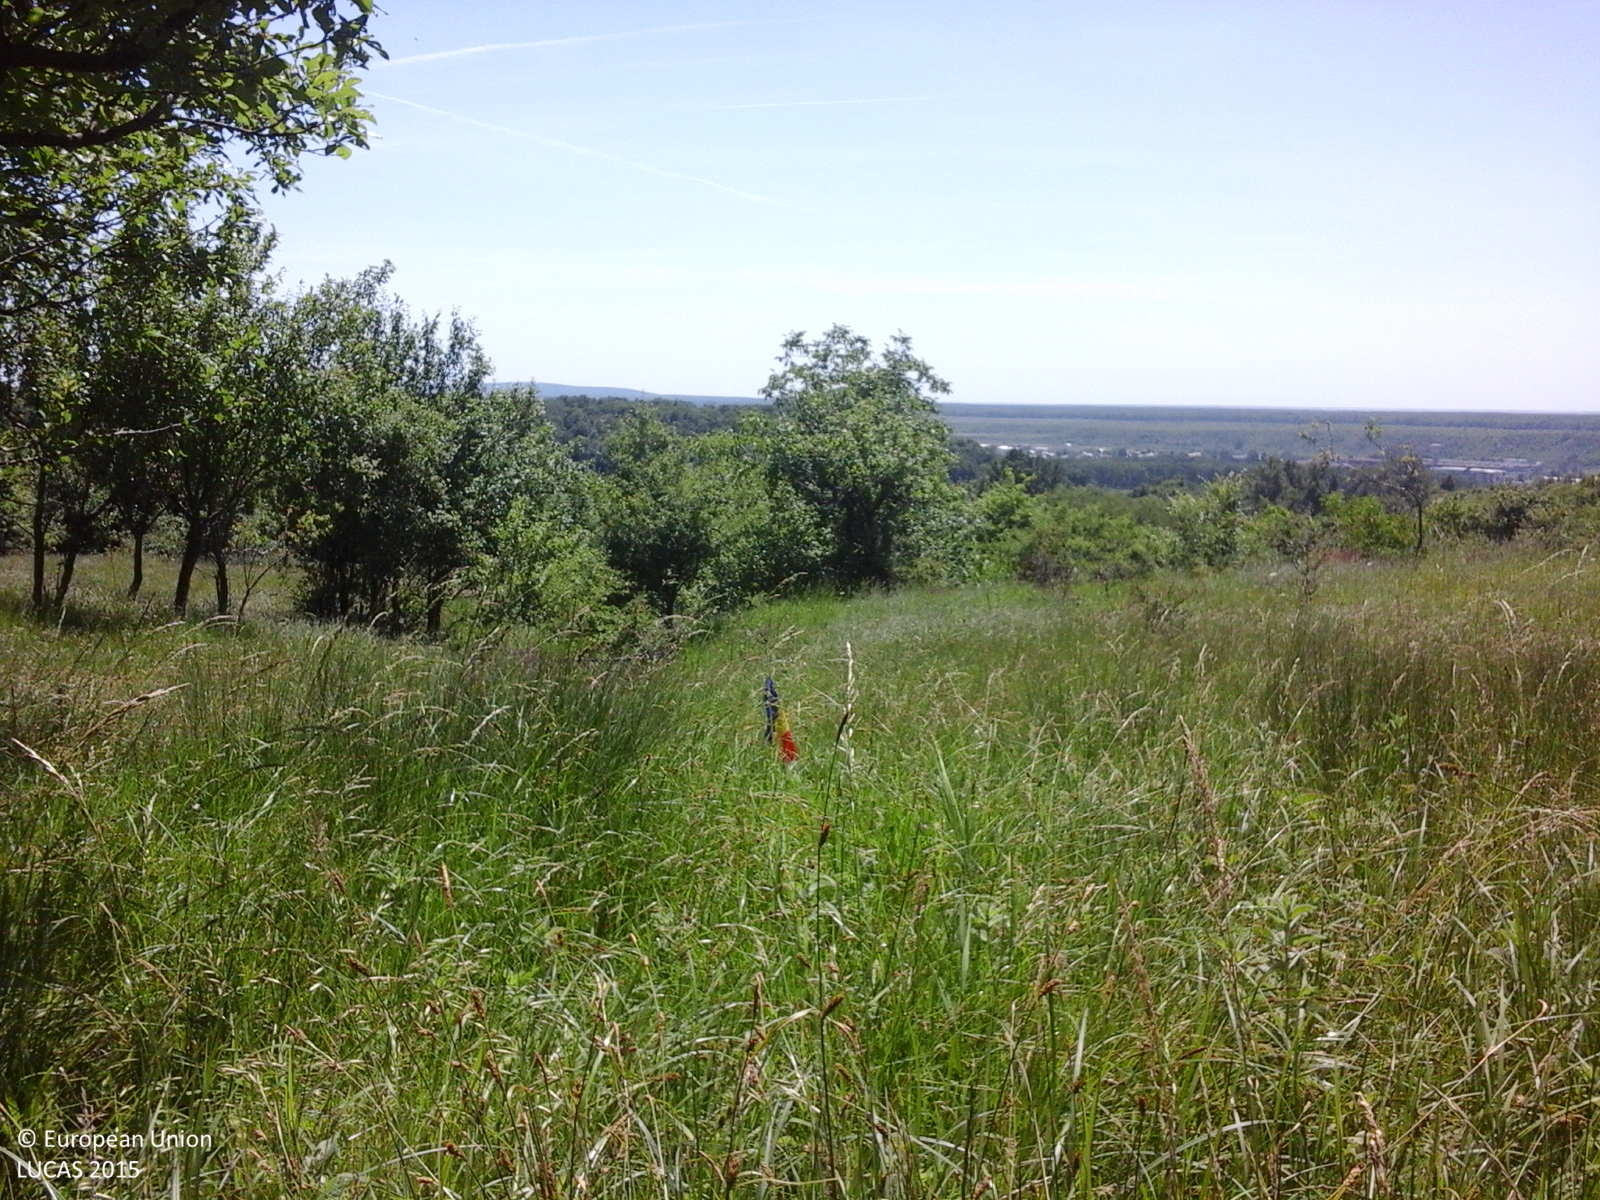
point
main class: Grassland
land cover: Grassland with sparse tree/shrub cover
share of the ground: > 75 %
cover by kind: herbaceous plants 85 %, shrubs 10 %, broadleaved forest trees 5 %
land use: Agriculture (excluding fallow land and kitchen gardens)
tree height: < 5 m
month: June
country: RO
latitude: 44.9867
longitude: 25.6620
